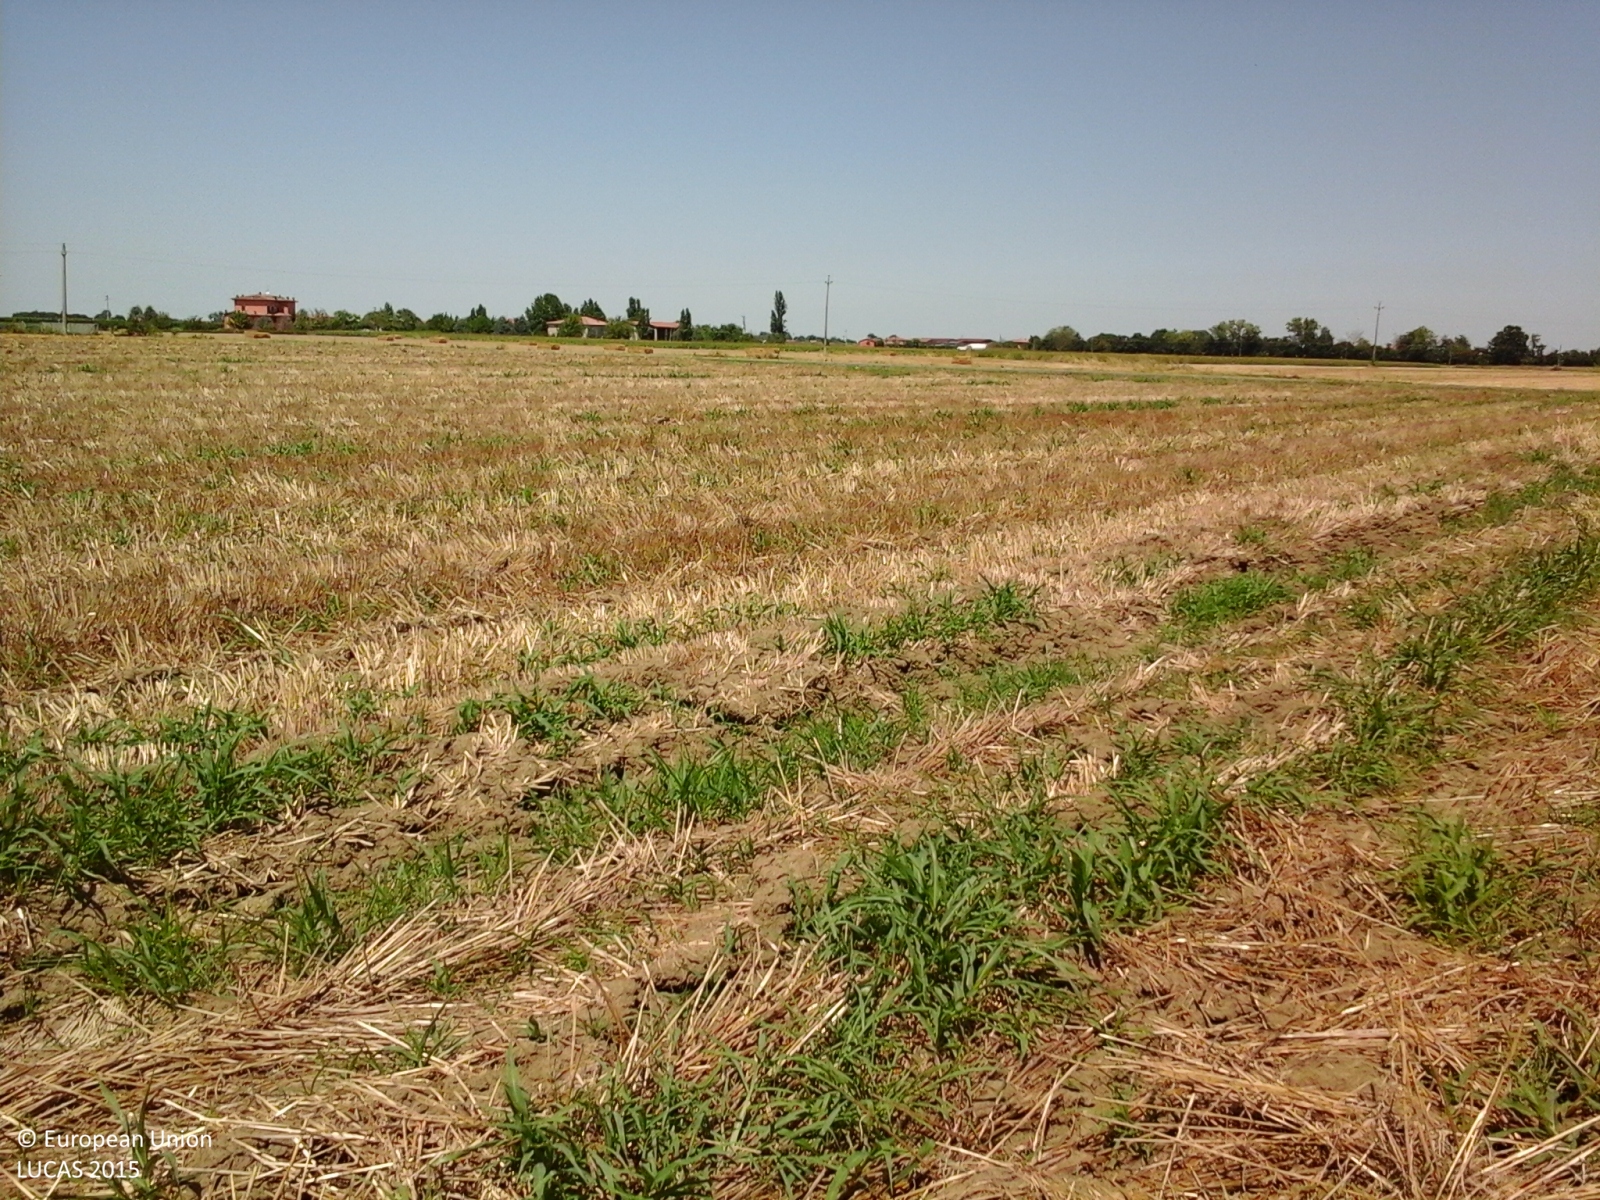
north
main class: Cropland
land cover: Common wheat
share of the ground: > 75 %
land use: Agriculture (excluding fallow land and kitchen gardens)
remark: Harvested field
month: July
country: IT
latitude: 44.4462
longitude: 11.6174
